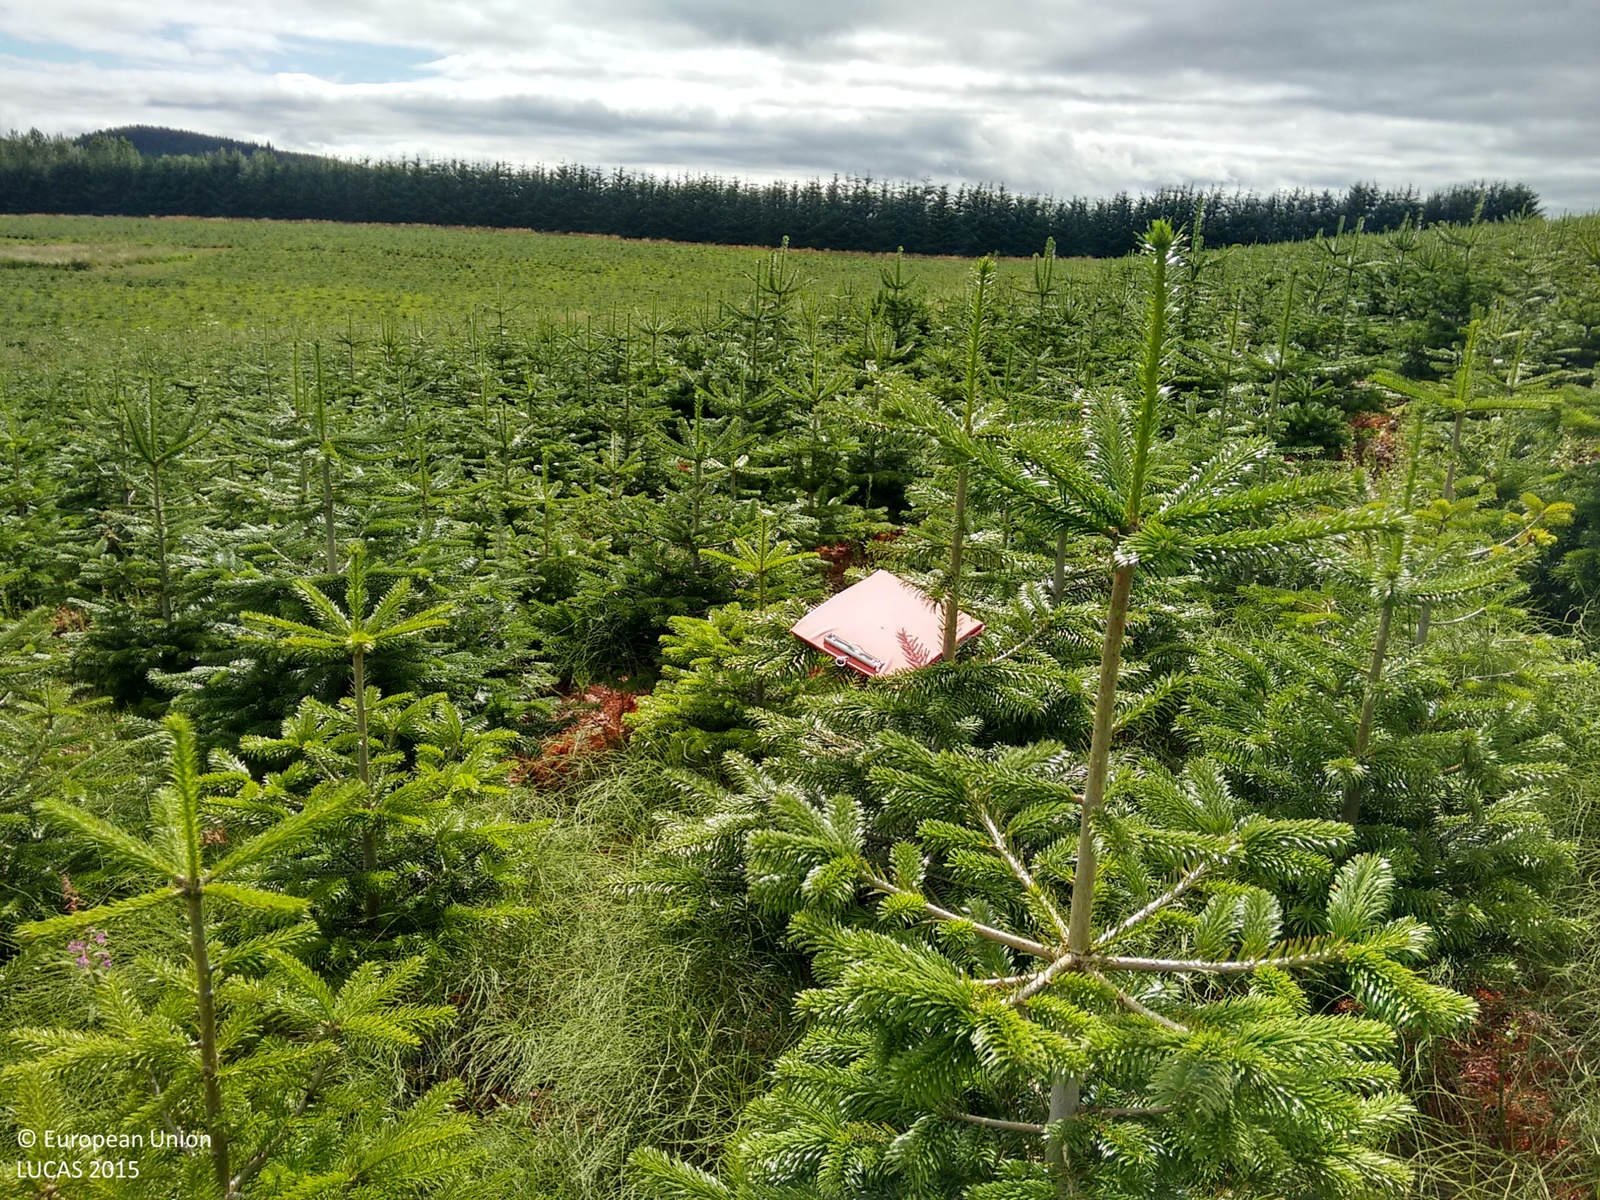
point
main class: Woodland
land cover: Spruce dominated coniferous woodland
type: exotic forest
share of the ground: > 75 %
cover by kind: coniferous forest trees 70 %, herbaceous plants 15 %, unconsolidated bare surface 15 %
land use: Forestry
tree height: < 5 m
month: August
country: GB
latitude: 57.5299
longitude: -4.2306
